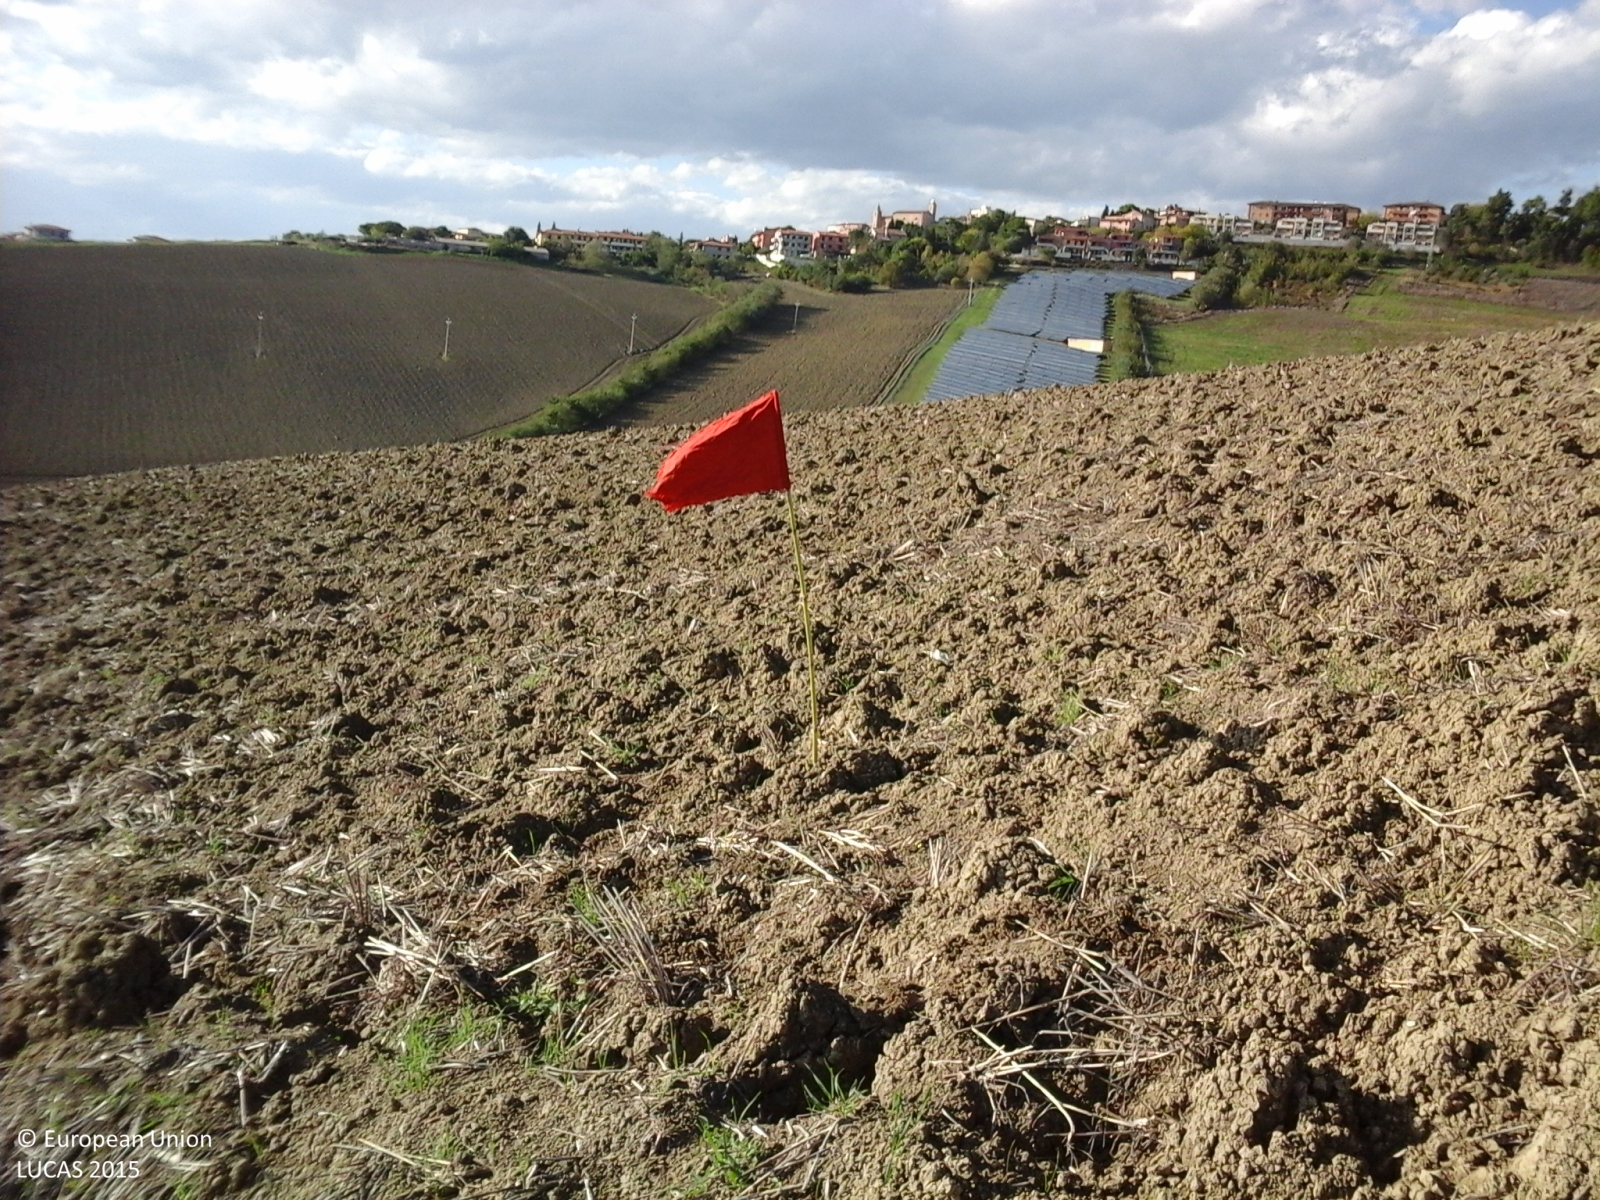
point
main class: Cropland
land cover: Durum wheat
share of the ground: < 10 %
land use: Agriculture (excluding fallow land and kitchen gardens)
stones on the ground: < 10 %
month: October
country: IT
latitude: 43.5367
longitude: 13.3949
